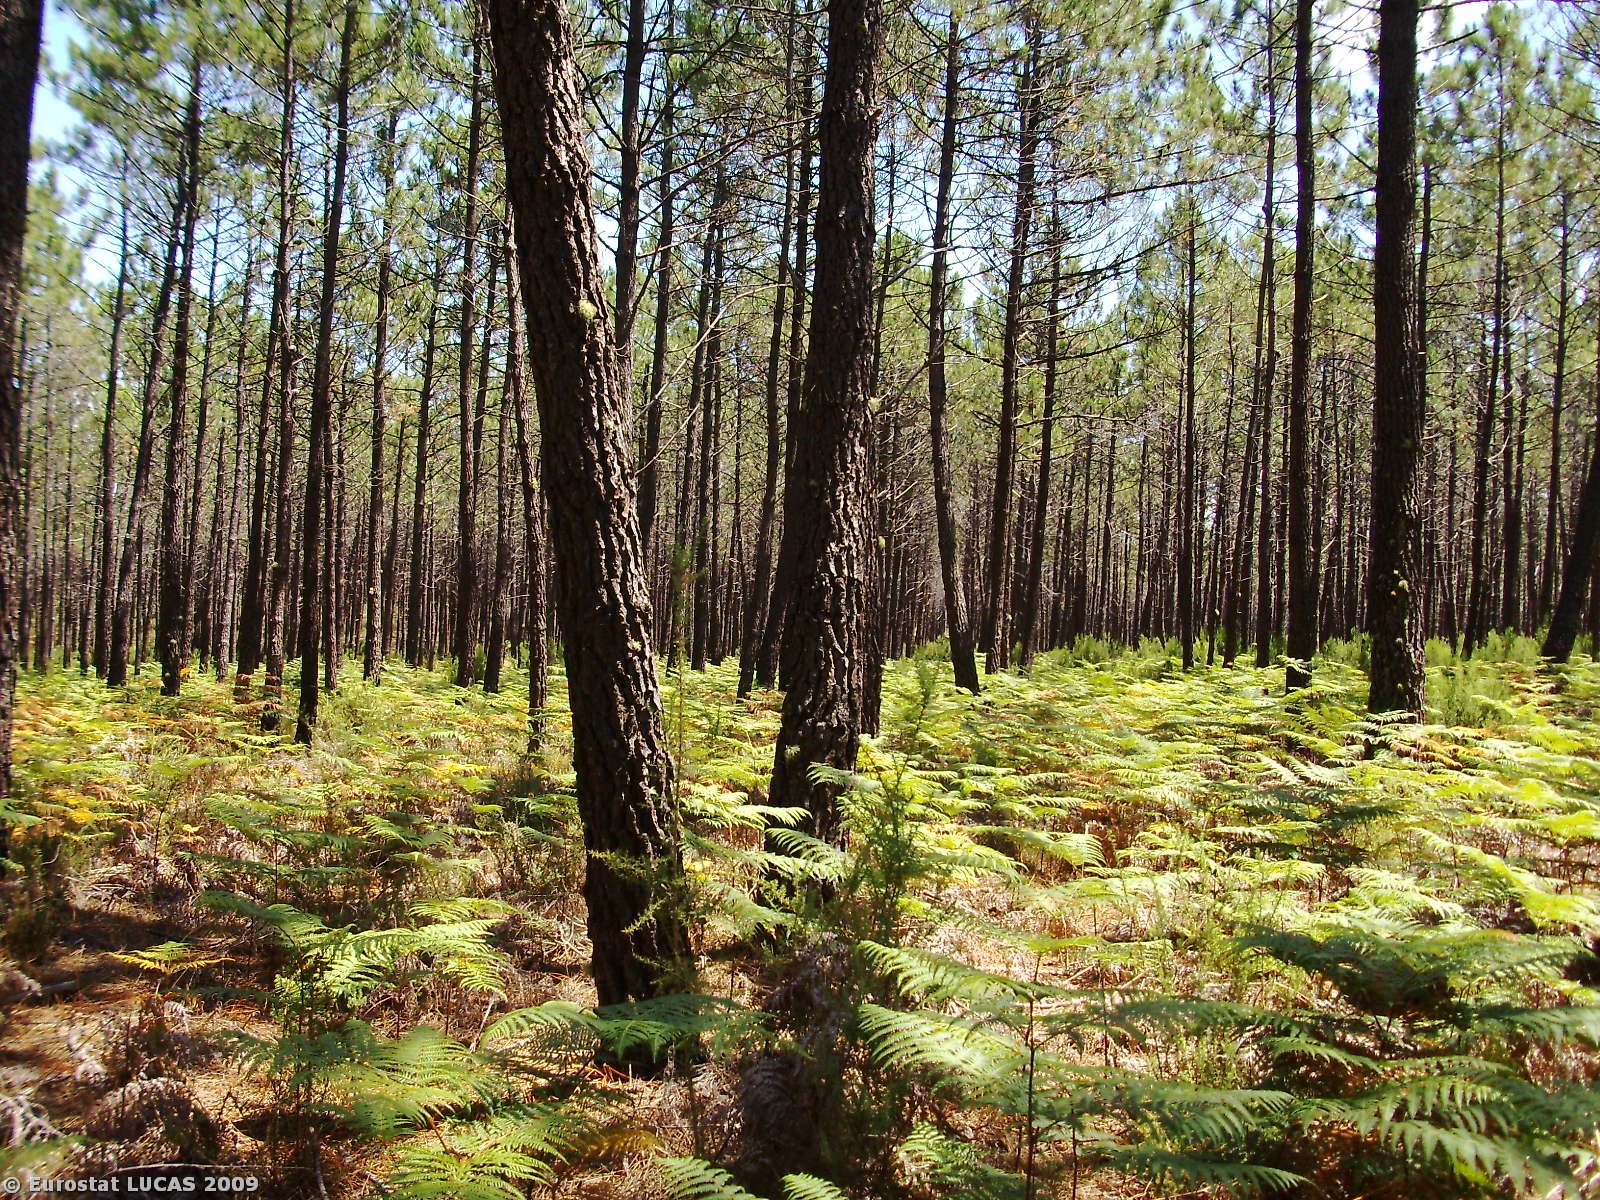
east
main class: Woodland
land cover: Coniferous woodland
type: coniferous forest of the mediterranean region
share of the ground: > 75 %
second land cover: Shrubland with sparse tree cover
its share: 10 - 25 %
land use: Forestry
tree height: > 5 m
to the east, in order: Coniferous woodland; Shrubland with sparse tree cover; Coniferous woodland
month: July
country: PT
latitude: 39.8343
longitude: -8.9154
